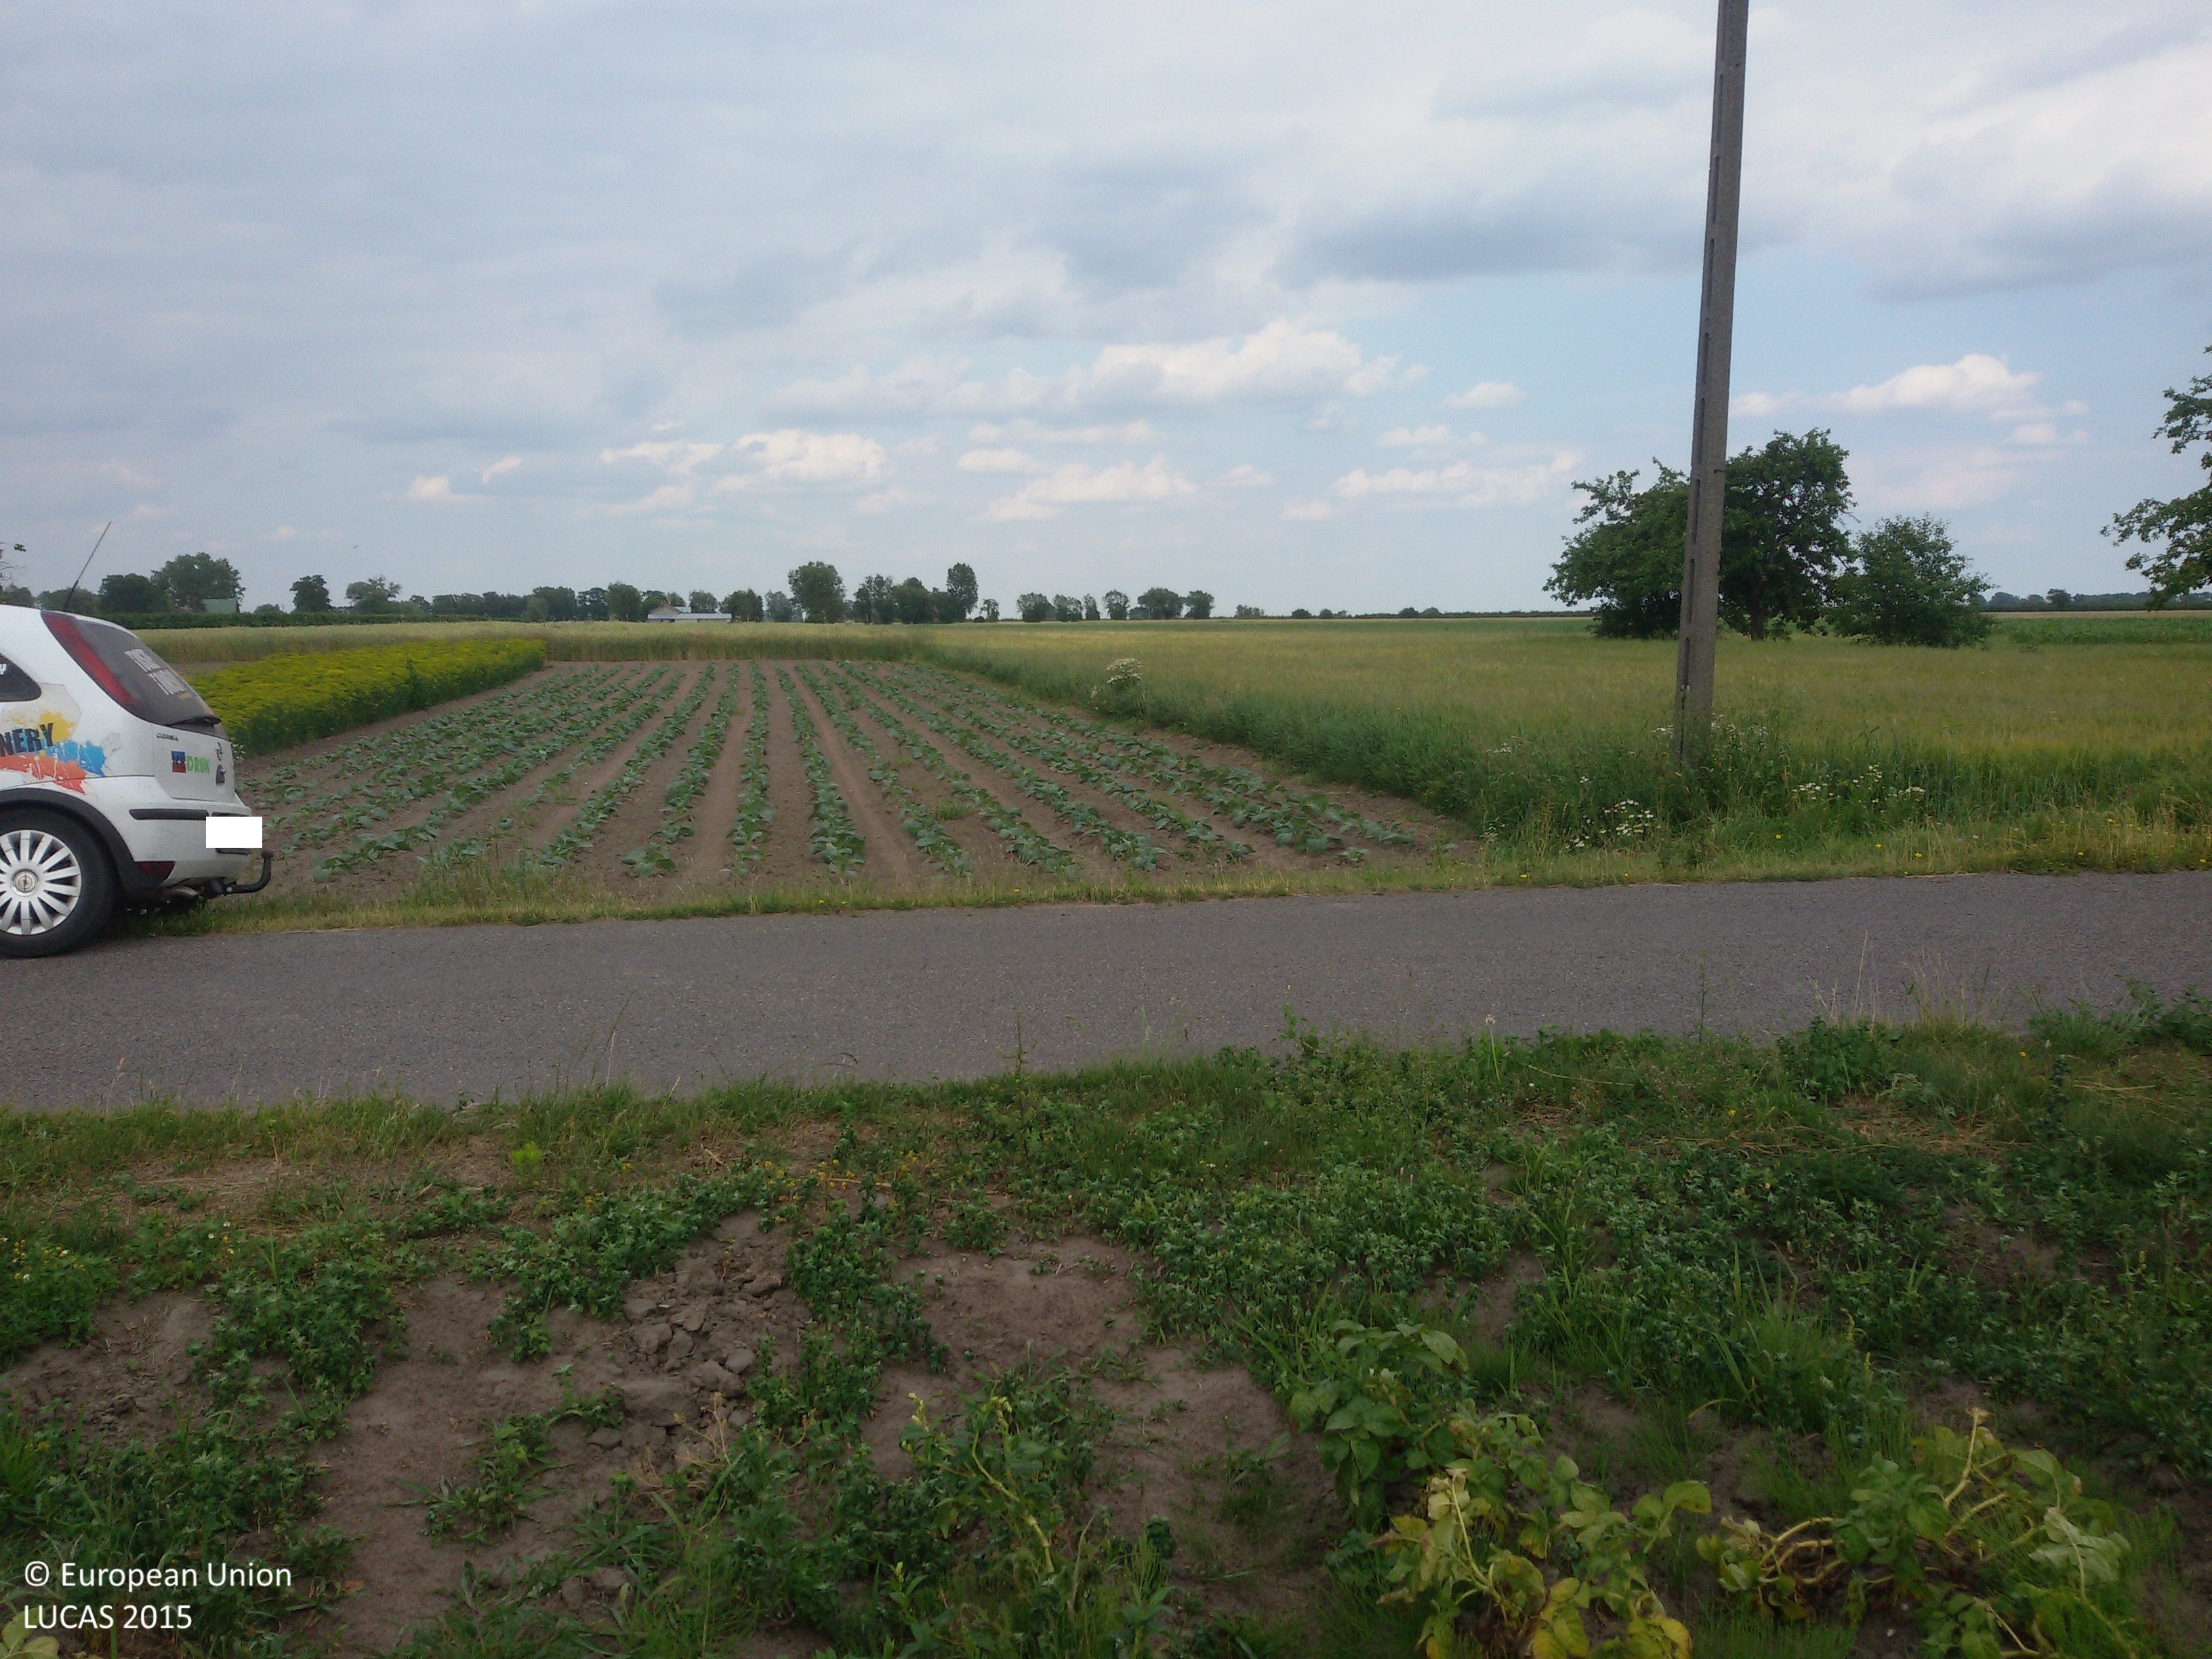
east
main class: Cropland
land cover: Potatoes
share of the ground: > 75 %
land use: Agriculture (excluding fallow land and kitchen gardens)
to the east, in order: Potatoes; Grass margins; Paved roads, cycling and walking lanes; Grass margins; Other fresh vegetables; Electric lines; Other fresh vegetables; Grass margins; Barley; Grass margins; Maize
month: June
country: PL
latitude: 52.2663
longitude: 19.9523
